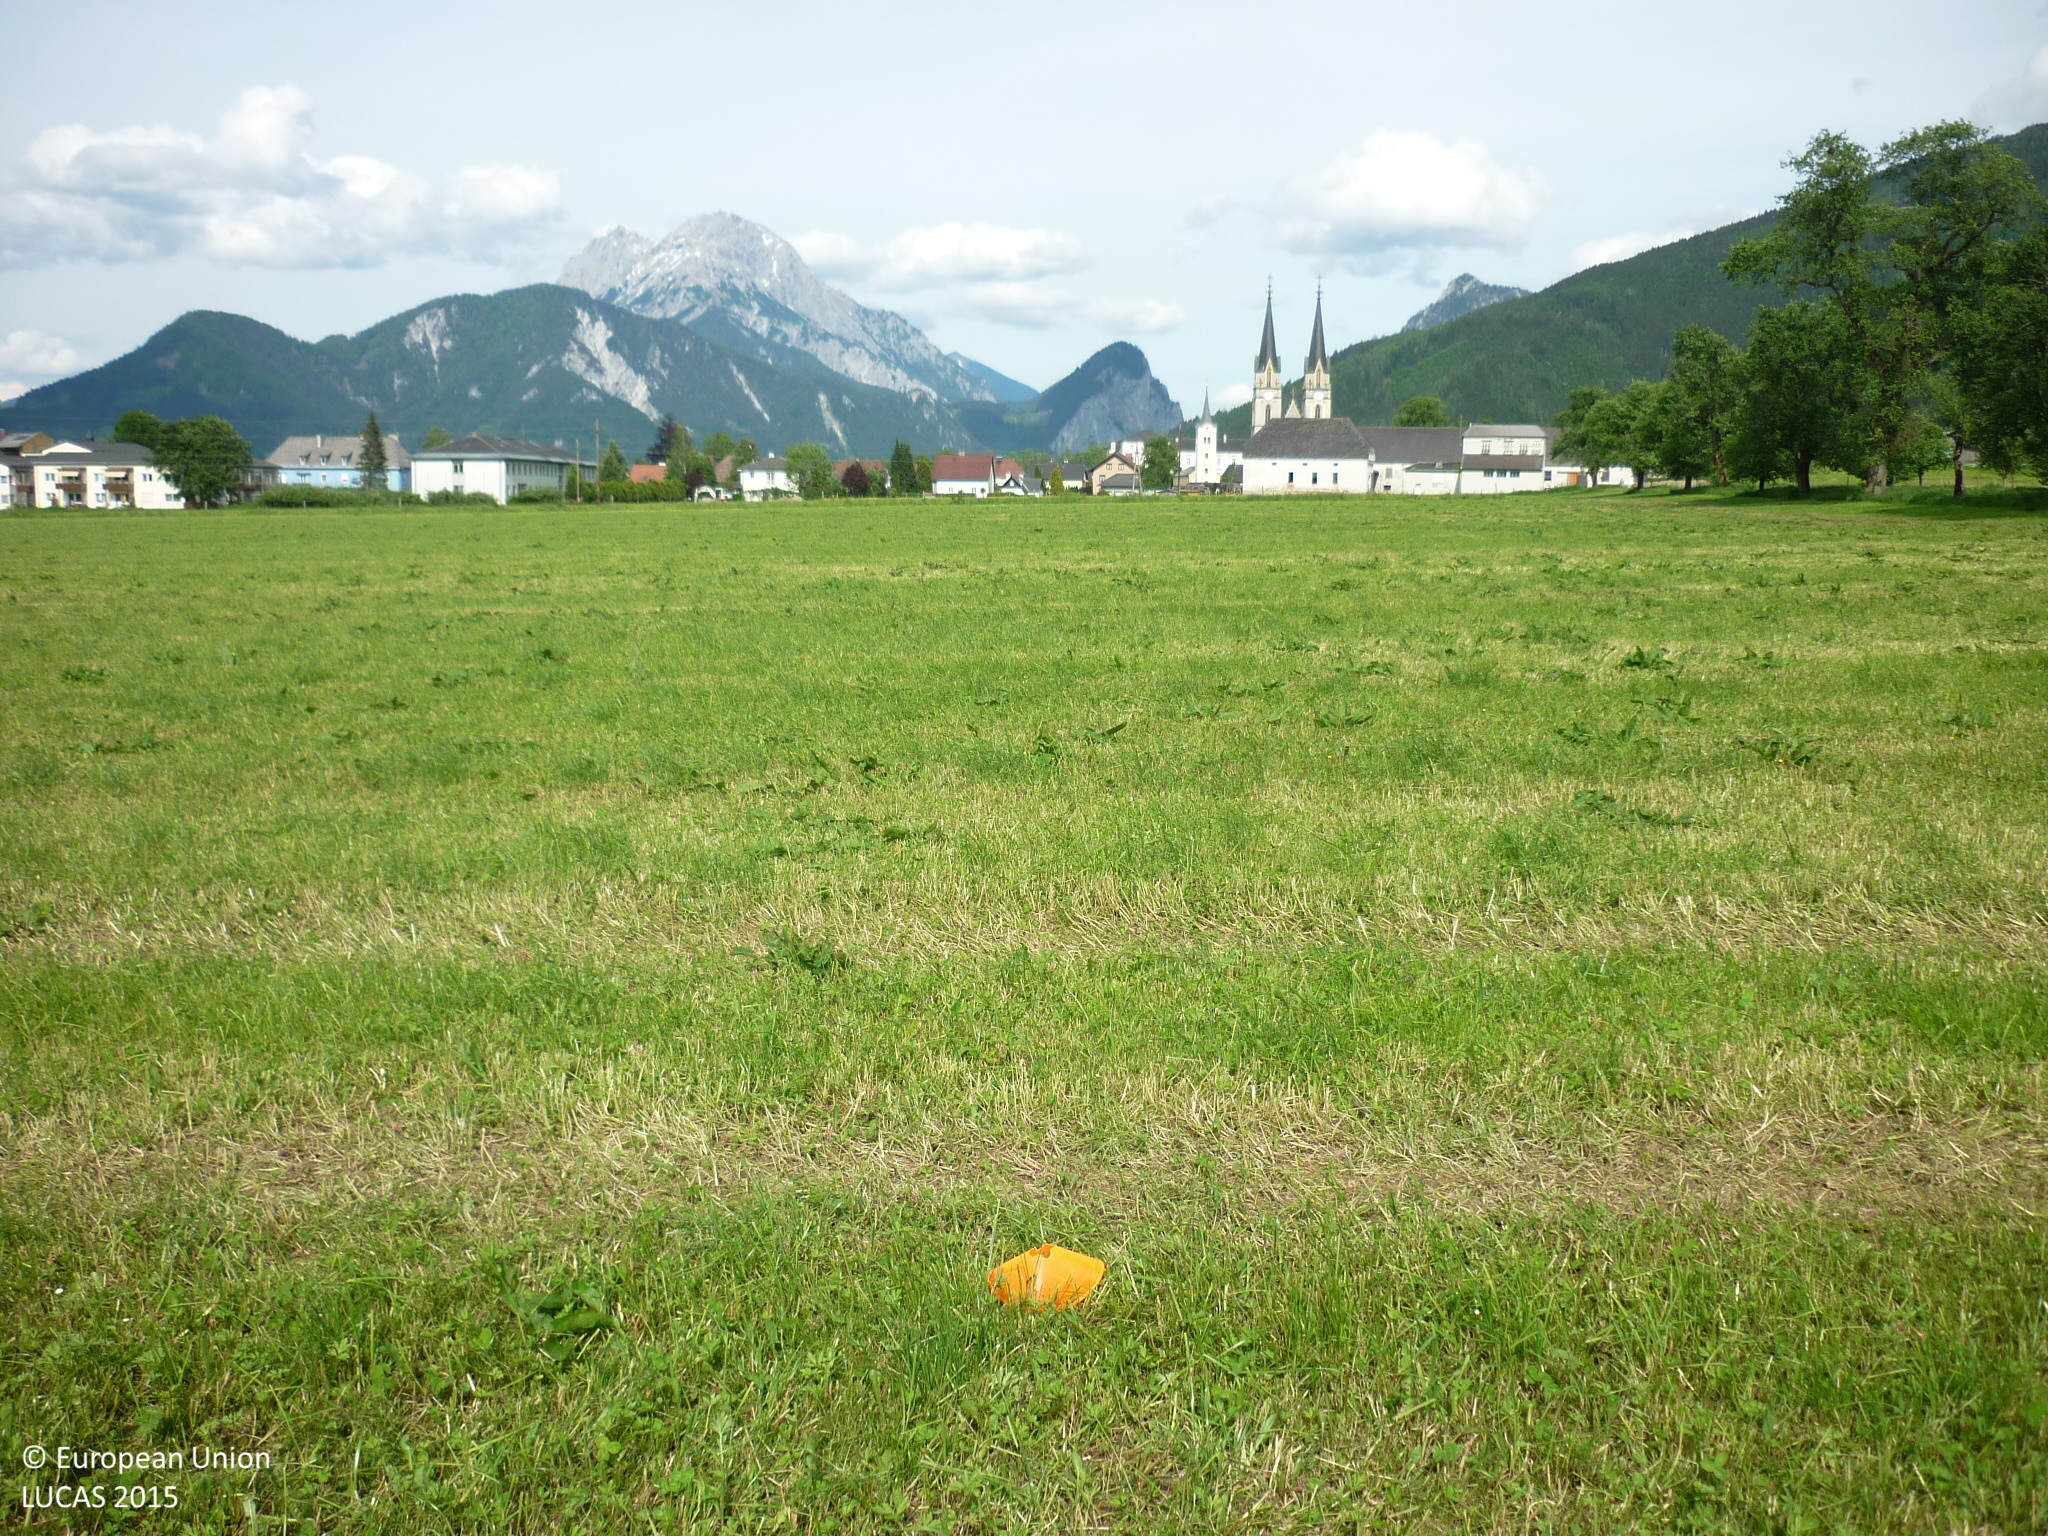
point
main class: Grassland
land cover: Grassland without tree/shrub cover
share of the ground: > 75 %
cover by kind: herbaceous plants 100 %
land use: Agriculture (excluding fallow land and kitchen gardens)
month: May
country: AT
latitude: 47.5749
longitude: 14.4528
